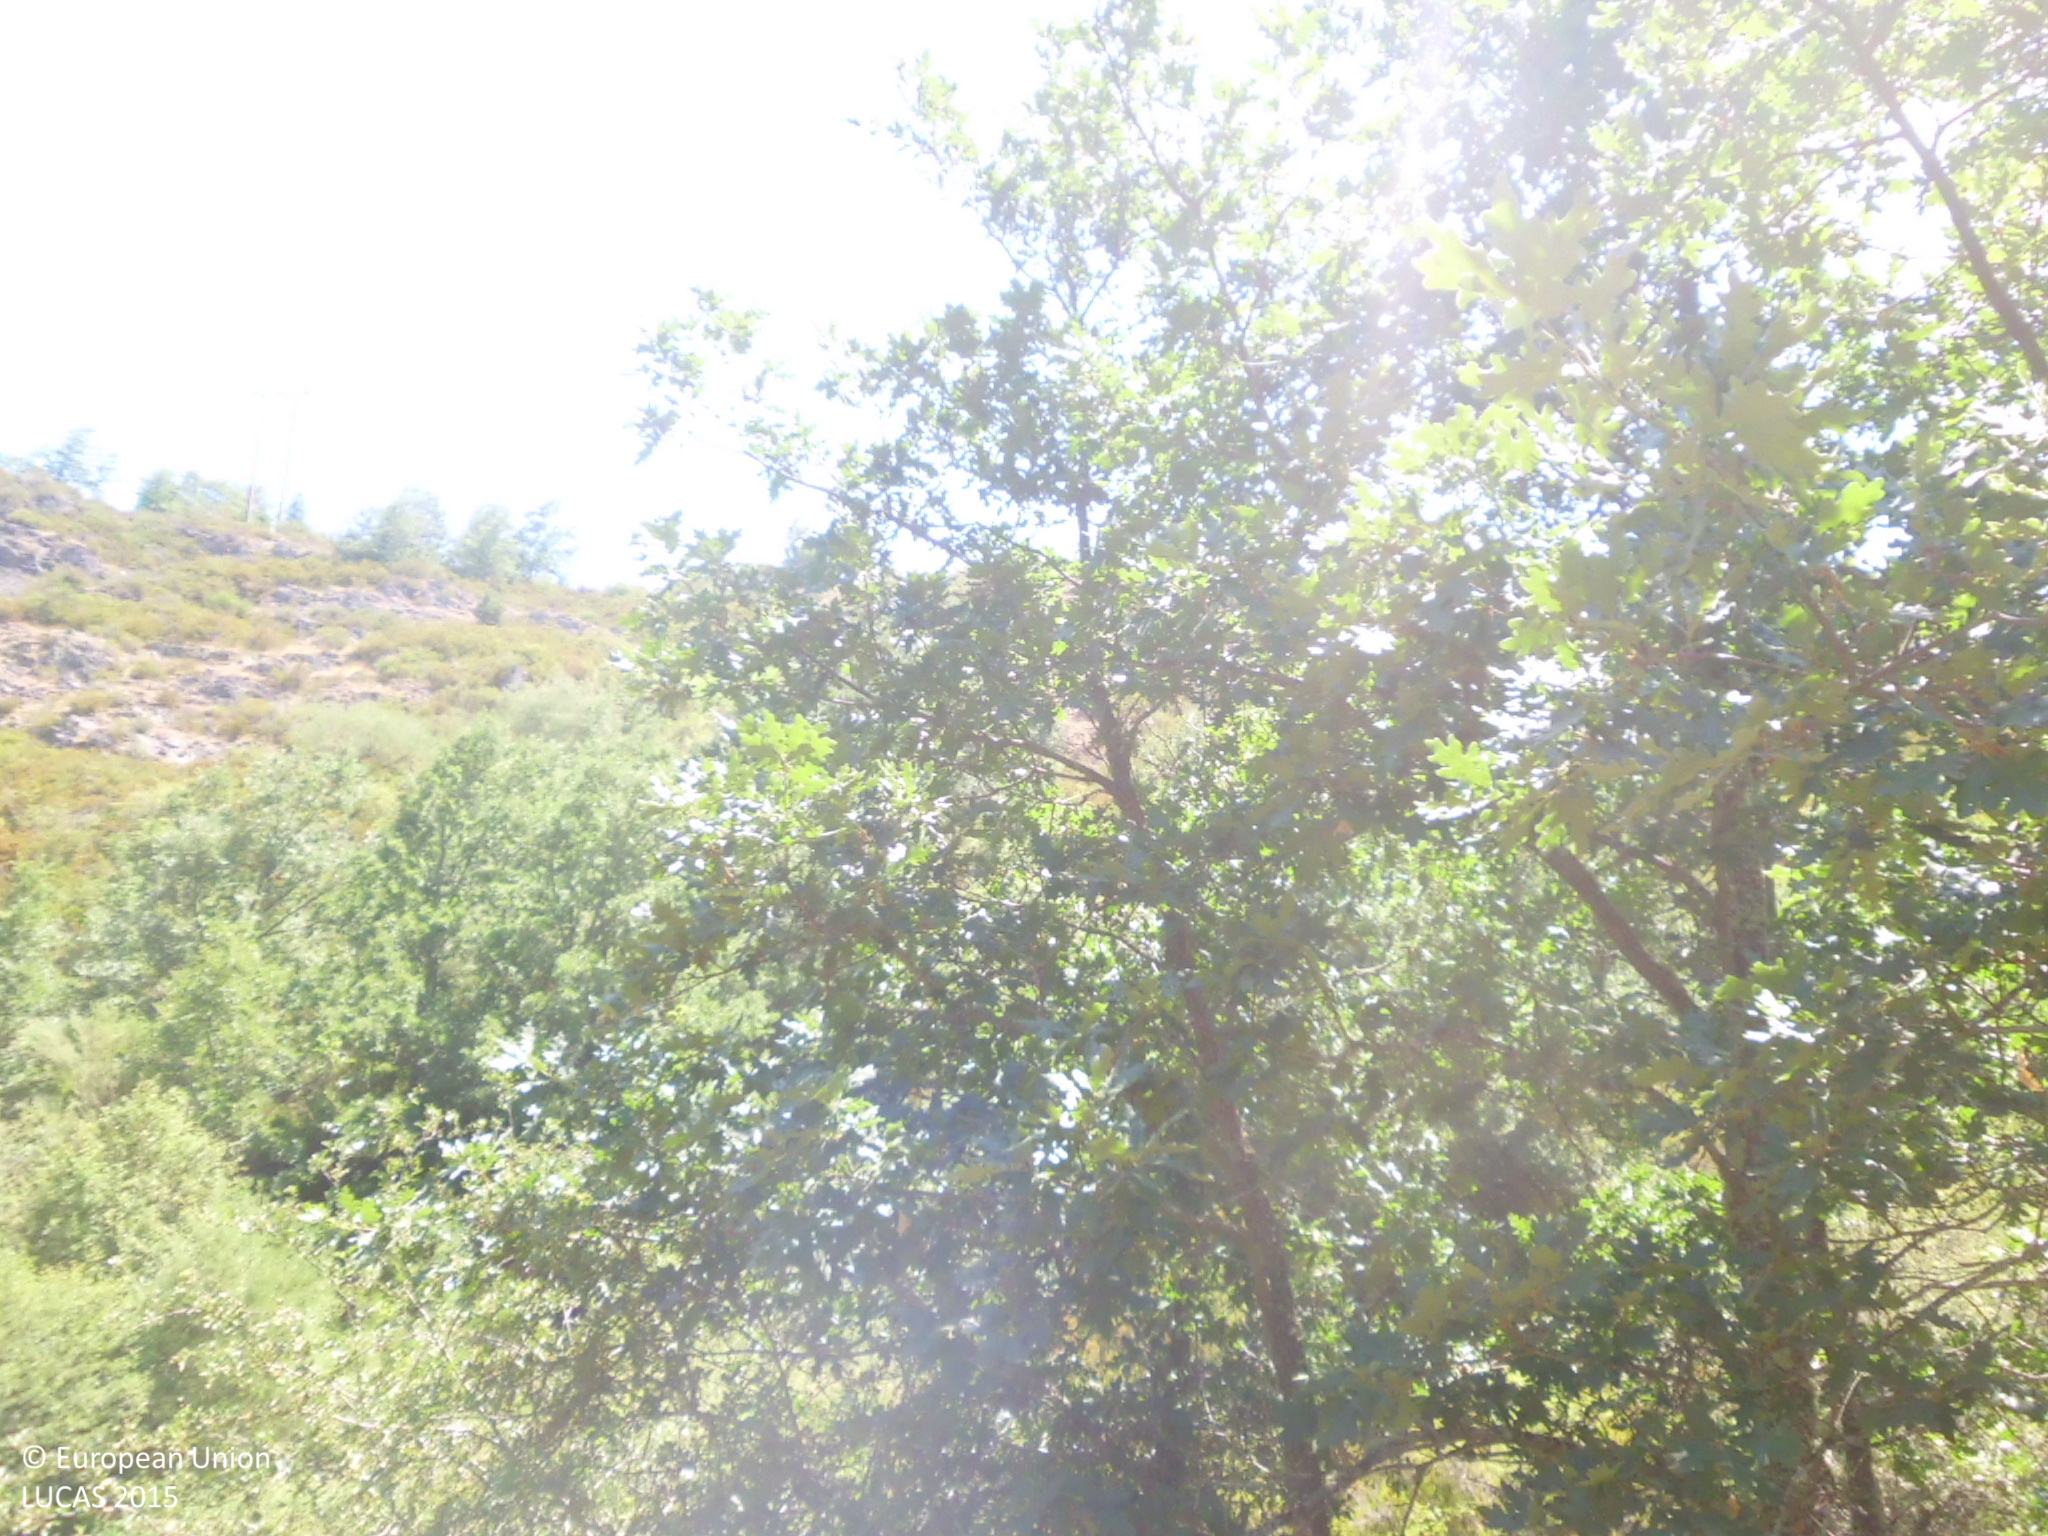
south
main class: Woodland
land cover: Broadleaved woodland
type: acidophilous oak and oak-birch forest
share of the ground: 50 - 75 %
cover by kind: broadleaved forest trees 60 %, shrubs 20 %, herbaceous plants 10 %, consolidated bare surface 10 %
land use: Semi-natural and natural areas not in use
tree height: > 5 m
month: July
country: ES
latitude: 42.2623
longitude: -3.3286
